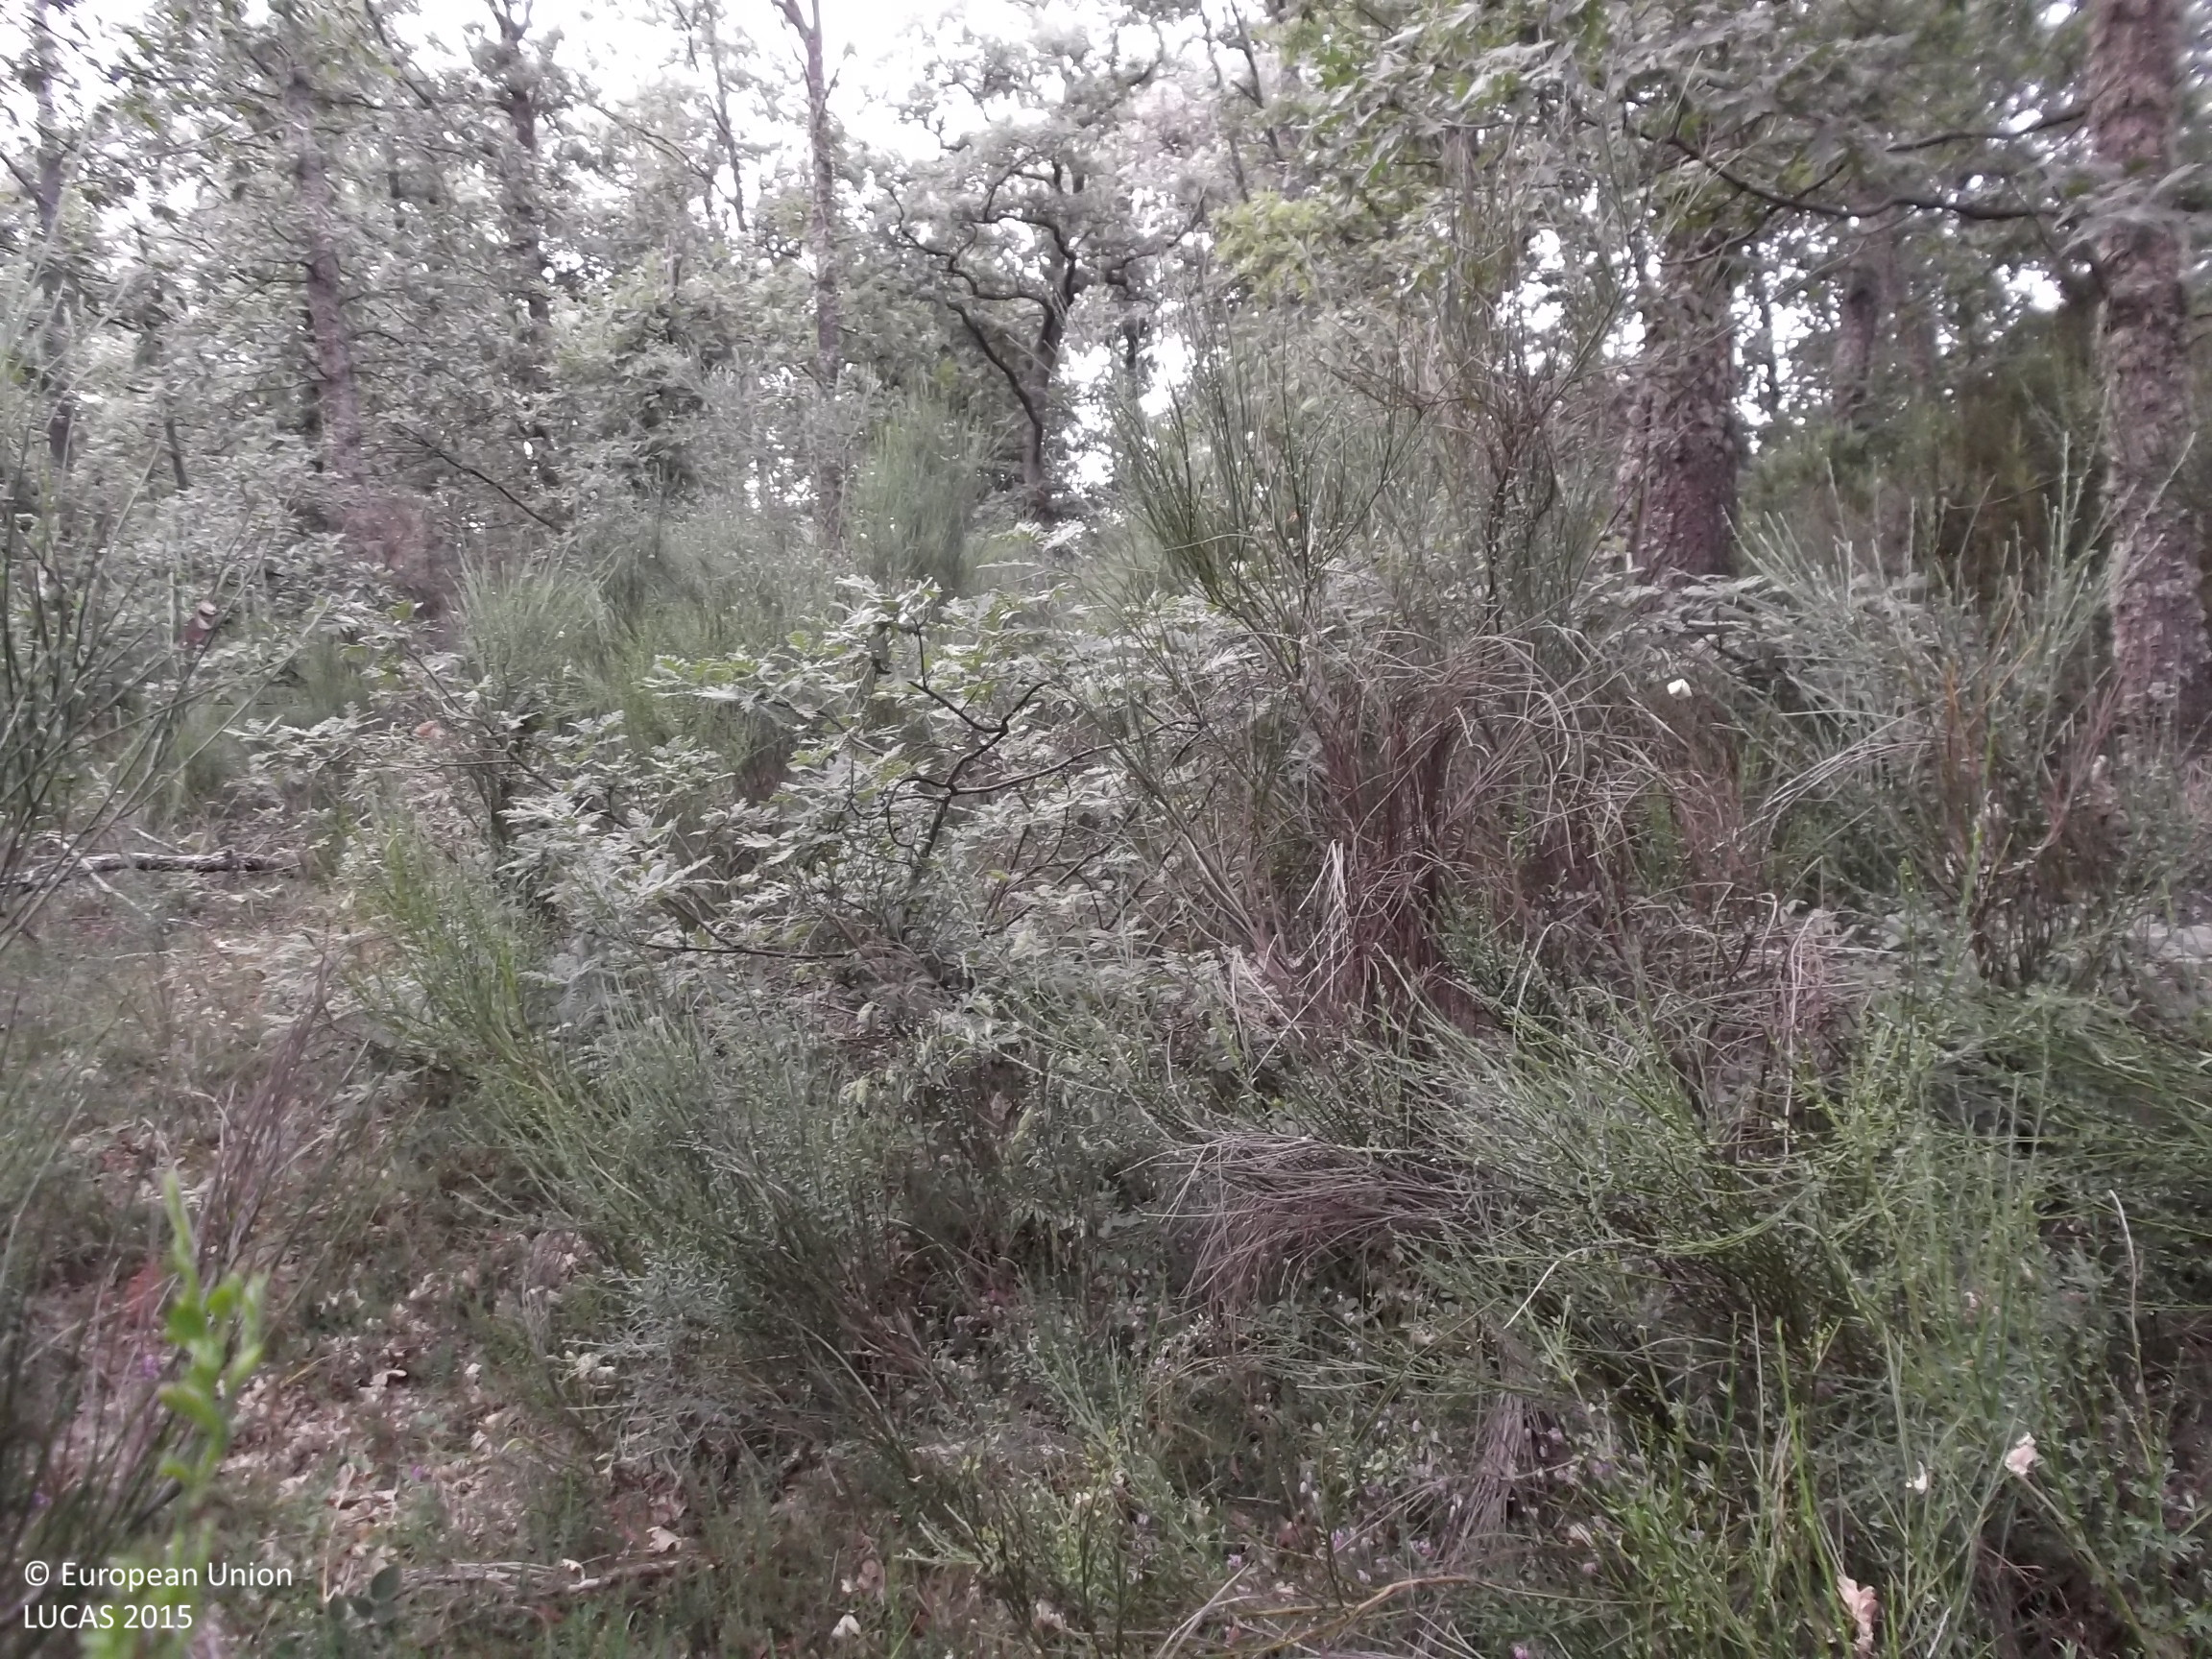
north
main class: Woodland
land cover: Broadleaved woodland
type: thermophilous deciduous forest
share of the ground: > 75 %
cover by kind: broadleaved forest trees 95 %
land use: Semi-natural and natural areas not in use
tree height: > 5 m
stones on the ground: < 10 %
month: July
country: ES
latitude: 42.3742
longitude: -3.0335
